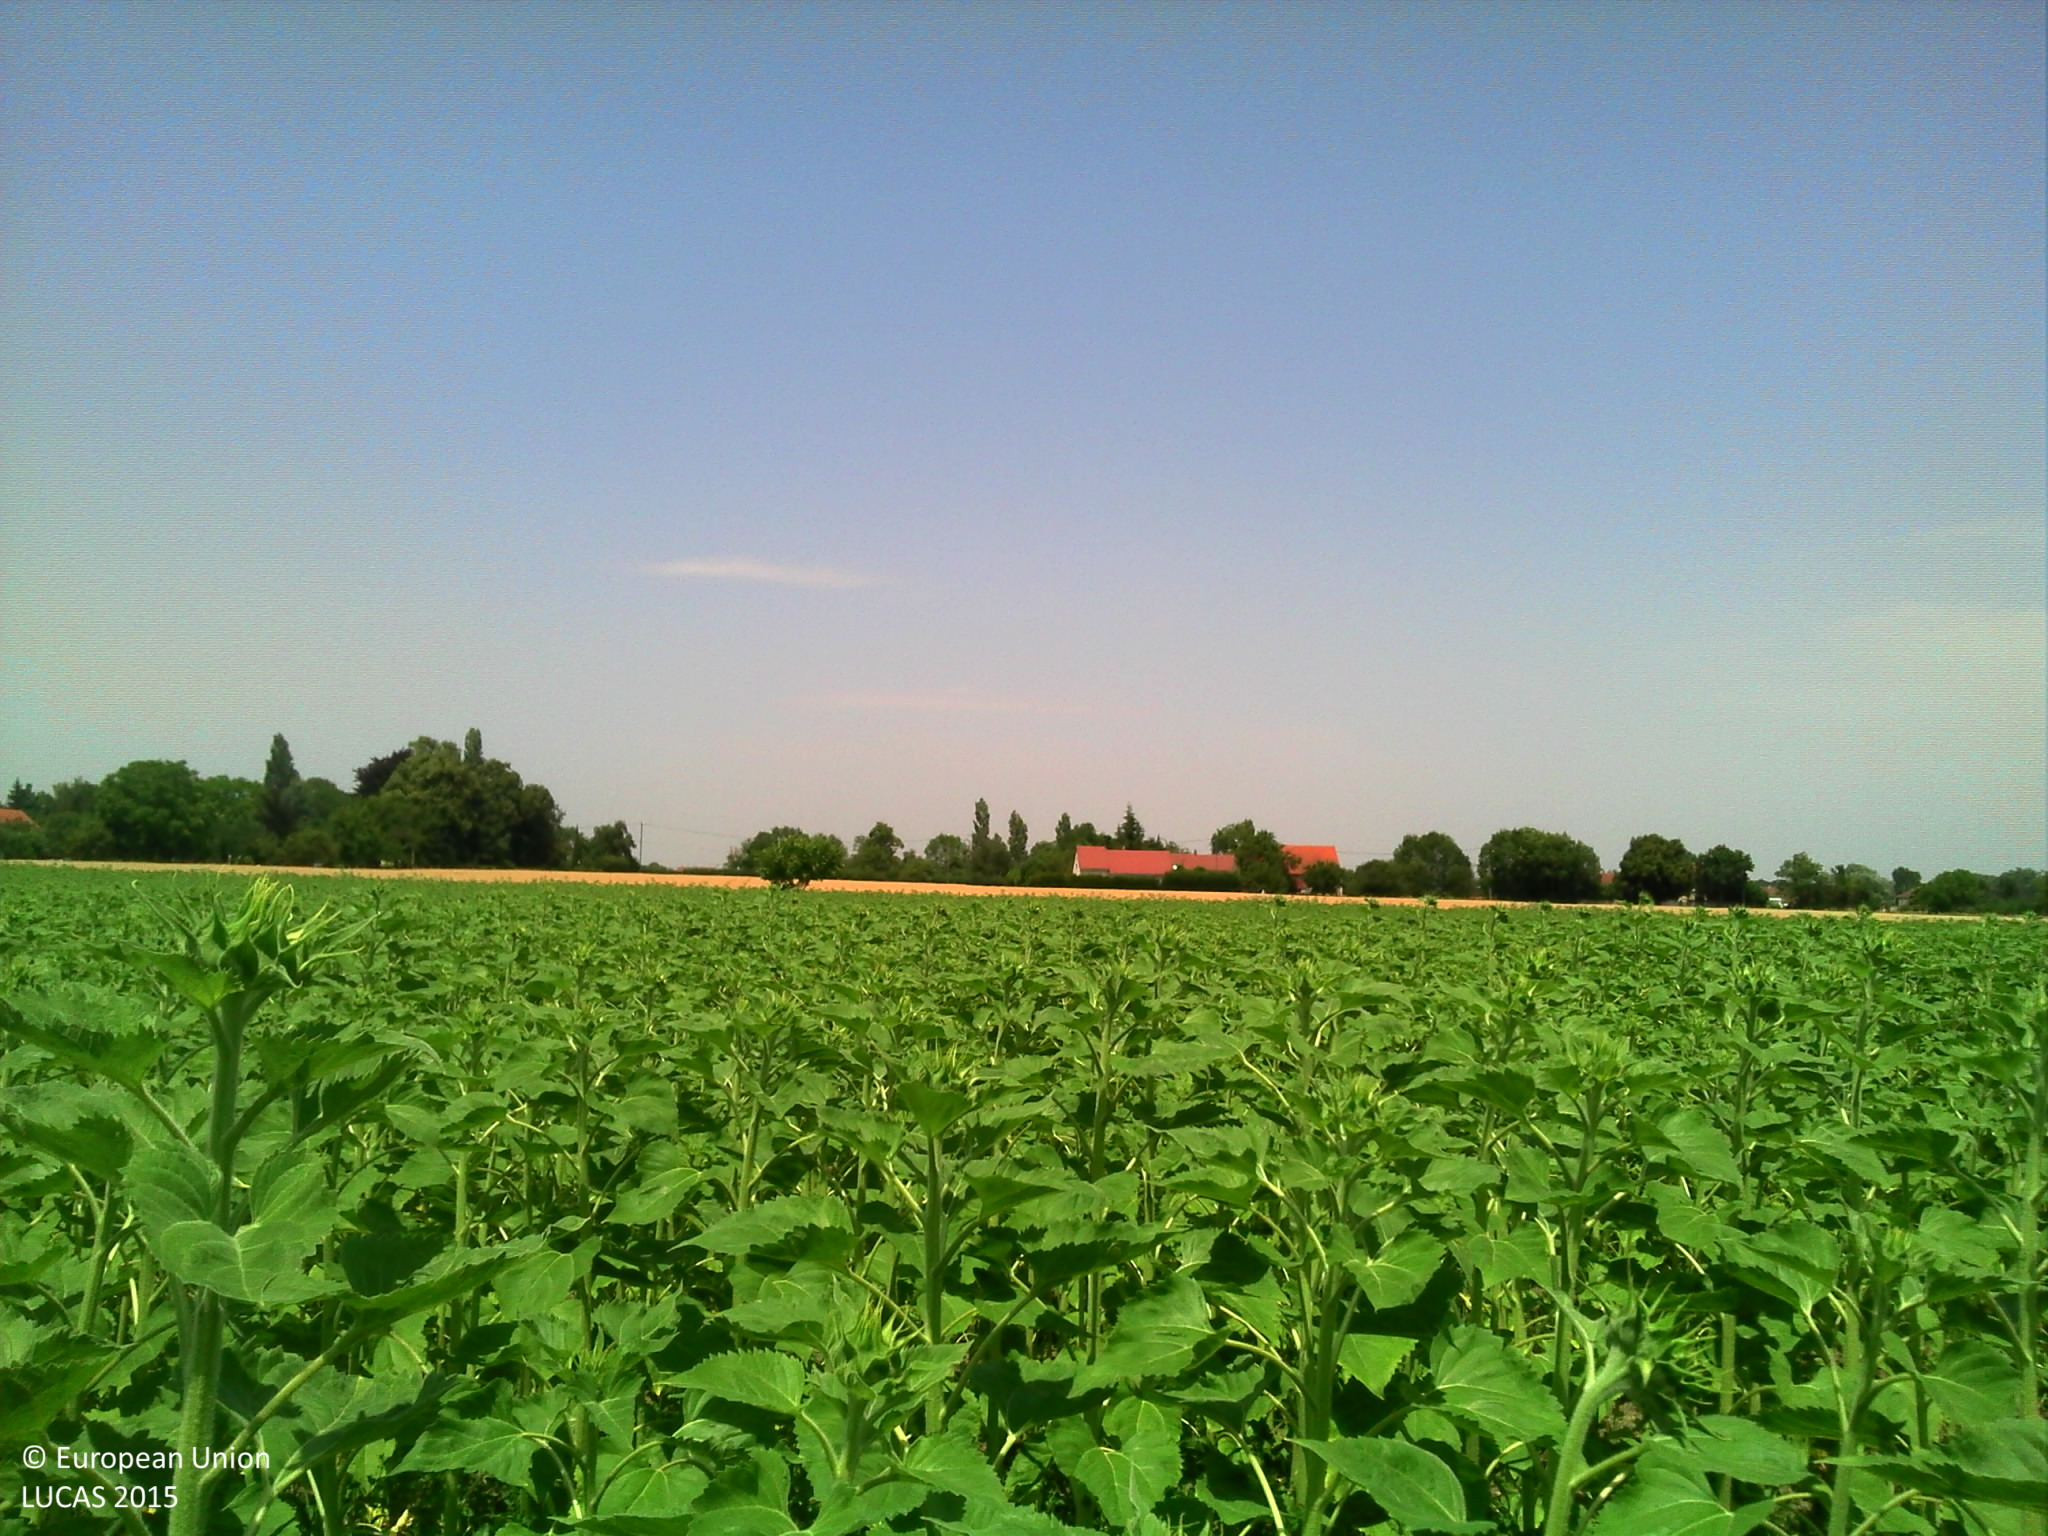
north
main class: Cropland
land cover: Sunflower
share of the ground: > 75 %
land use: Agriculture (excluding fallow land and kitchen gardens)
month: July
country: FR
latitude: 46.1040
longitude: 3.2852
